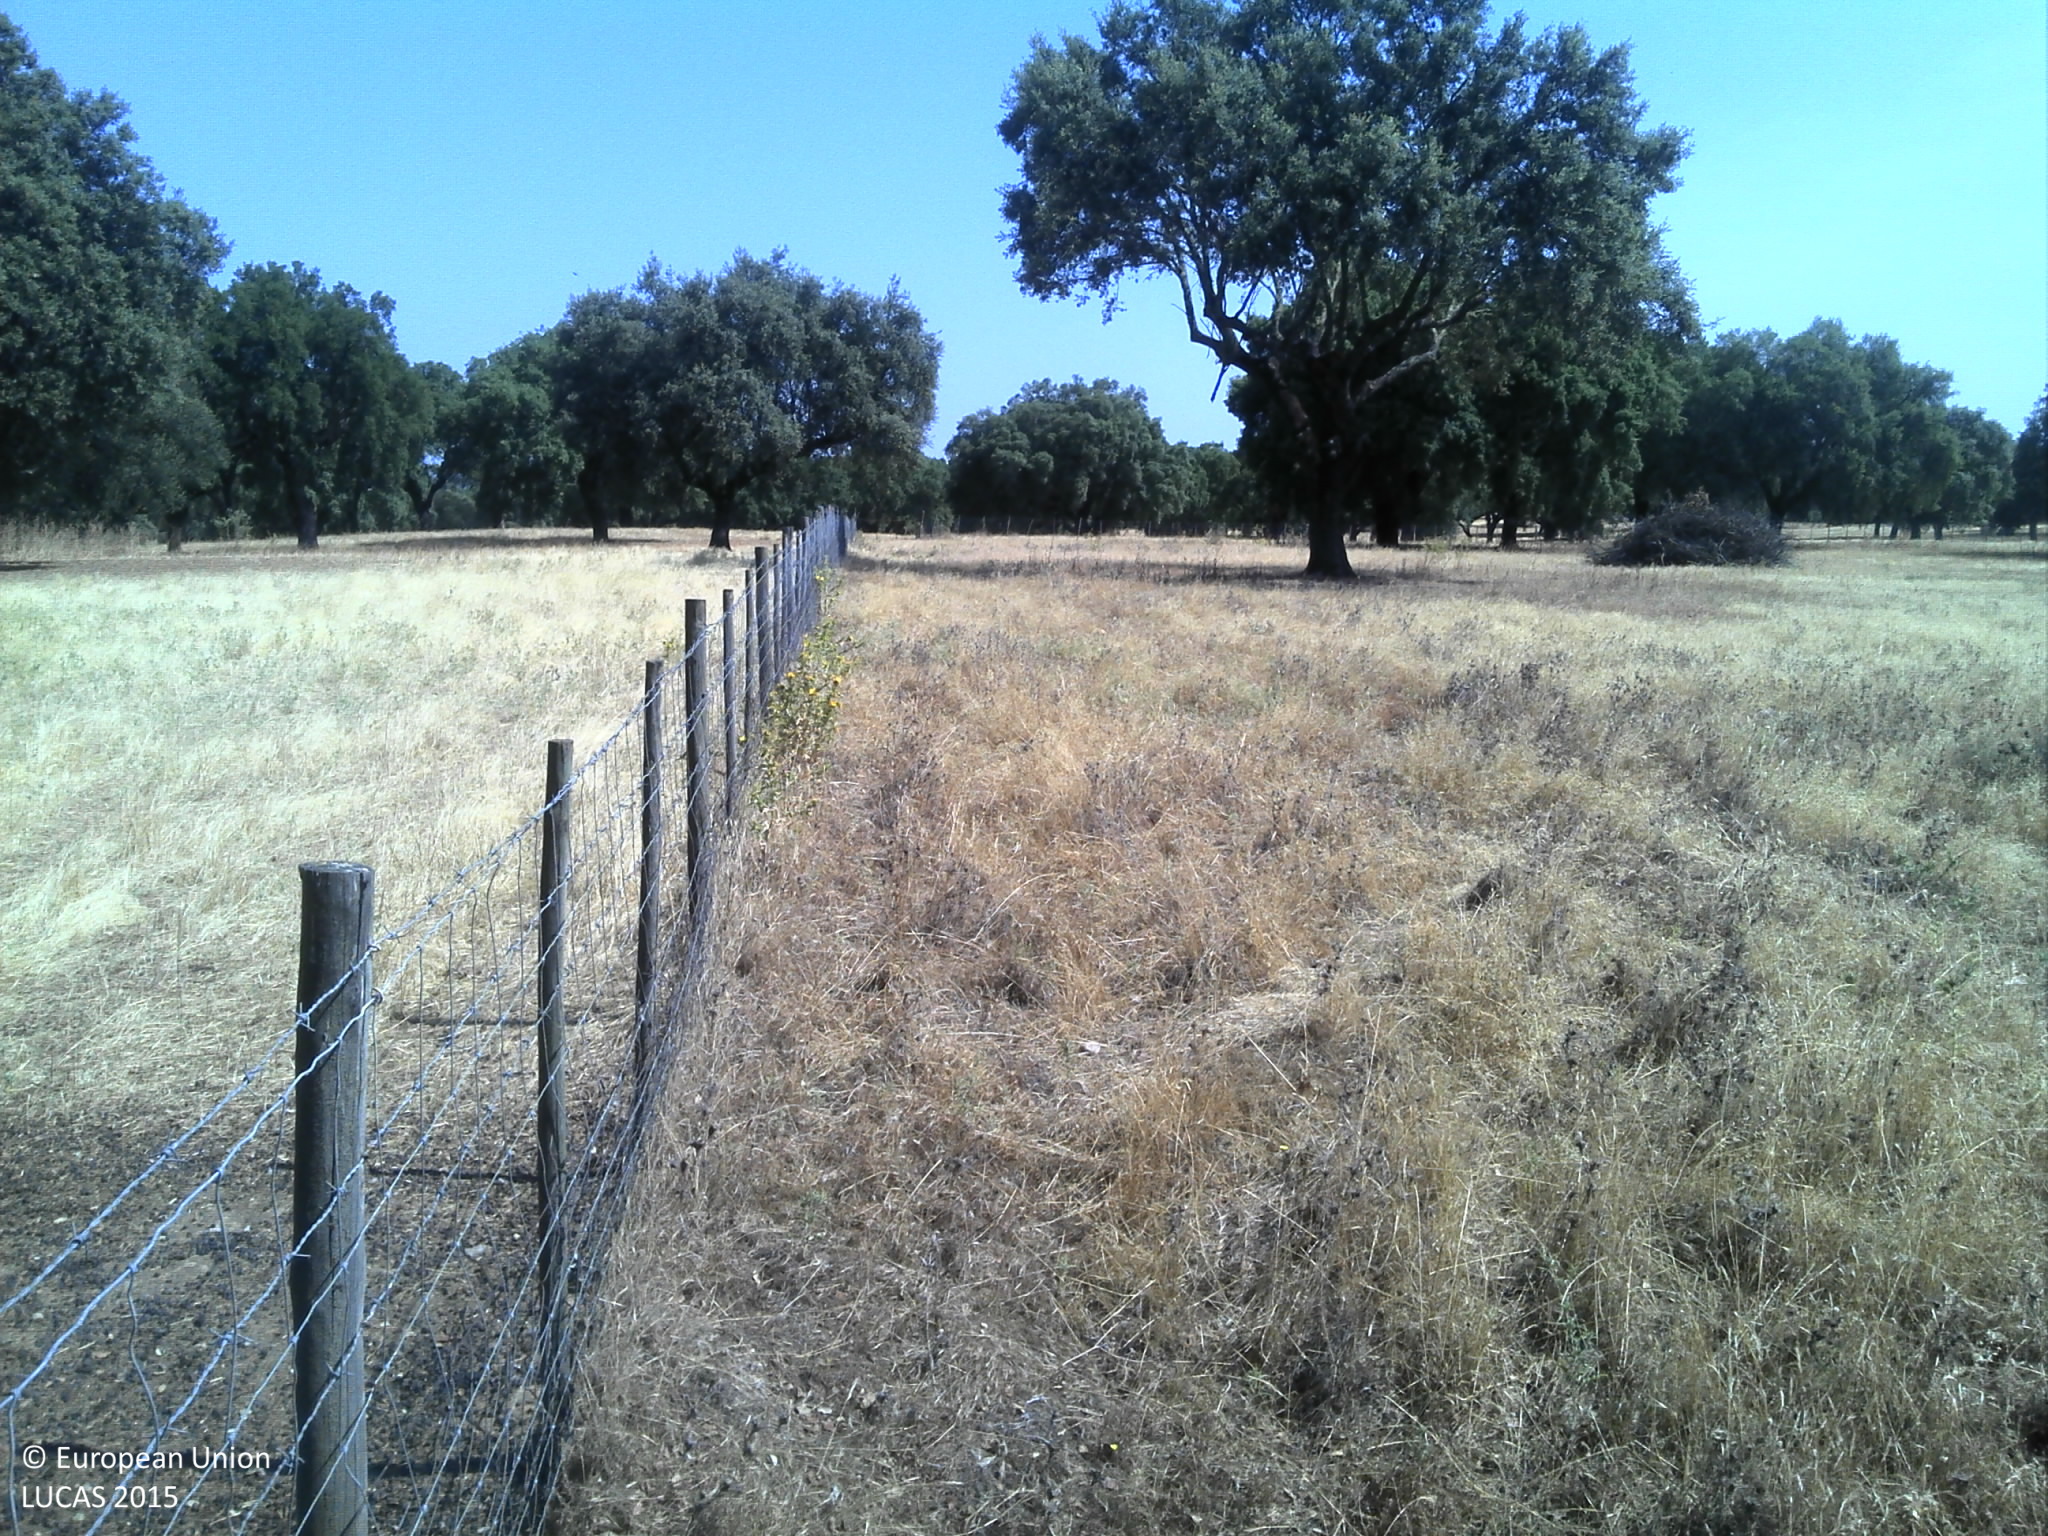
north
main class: Woodland
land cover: Broadleaved woodland
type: broadleaved evergreen forest
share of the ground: 25 - 50 %
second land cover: Grassland without tree/shrub cover
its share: 25 - 50 %
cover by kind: broadleaved forest trees 40 %, herbaceous plants 40 %, unconsolidated bare surface 15 %
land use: Forestry
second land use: Agriculture (excluding fallow land and kitchen gardens)
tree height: > 5 m
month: June
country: PT
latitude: 39.9036
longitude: -7.0624
